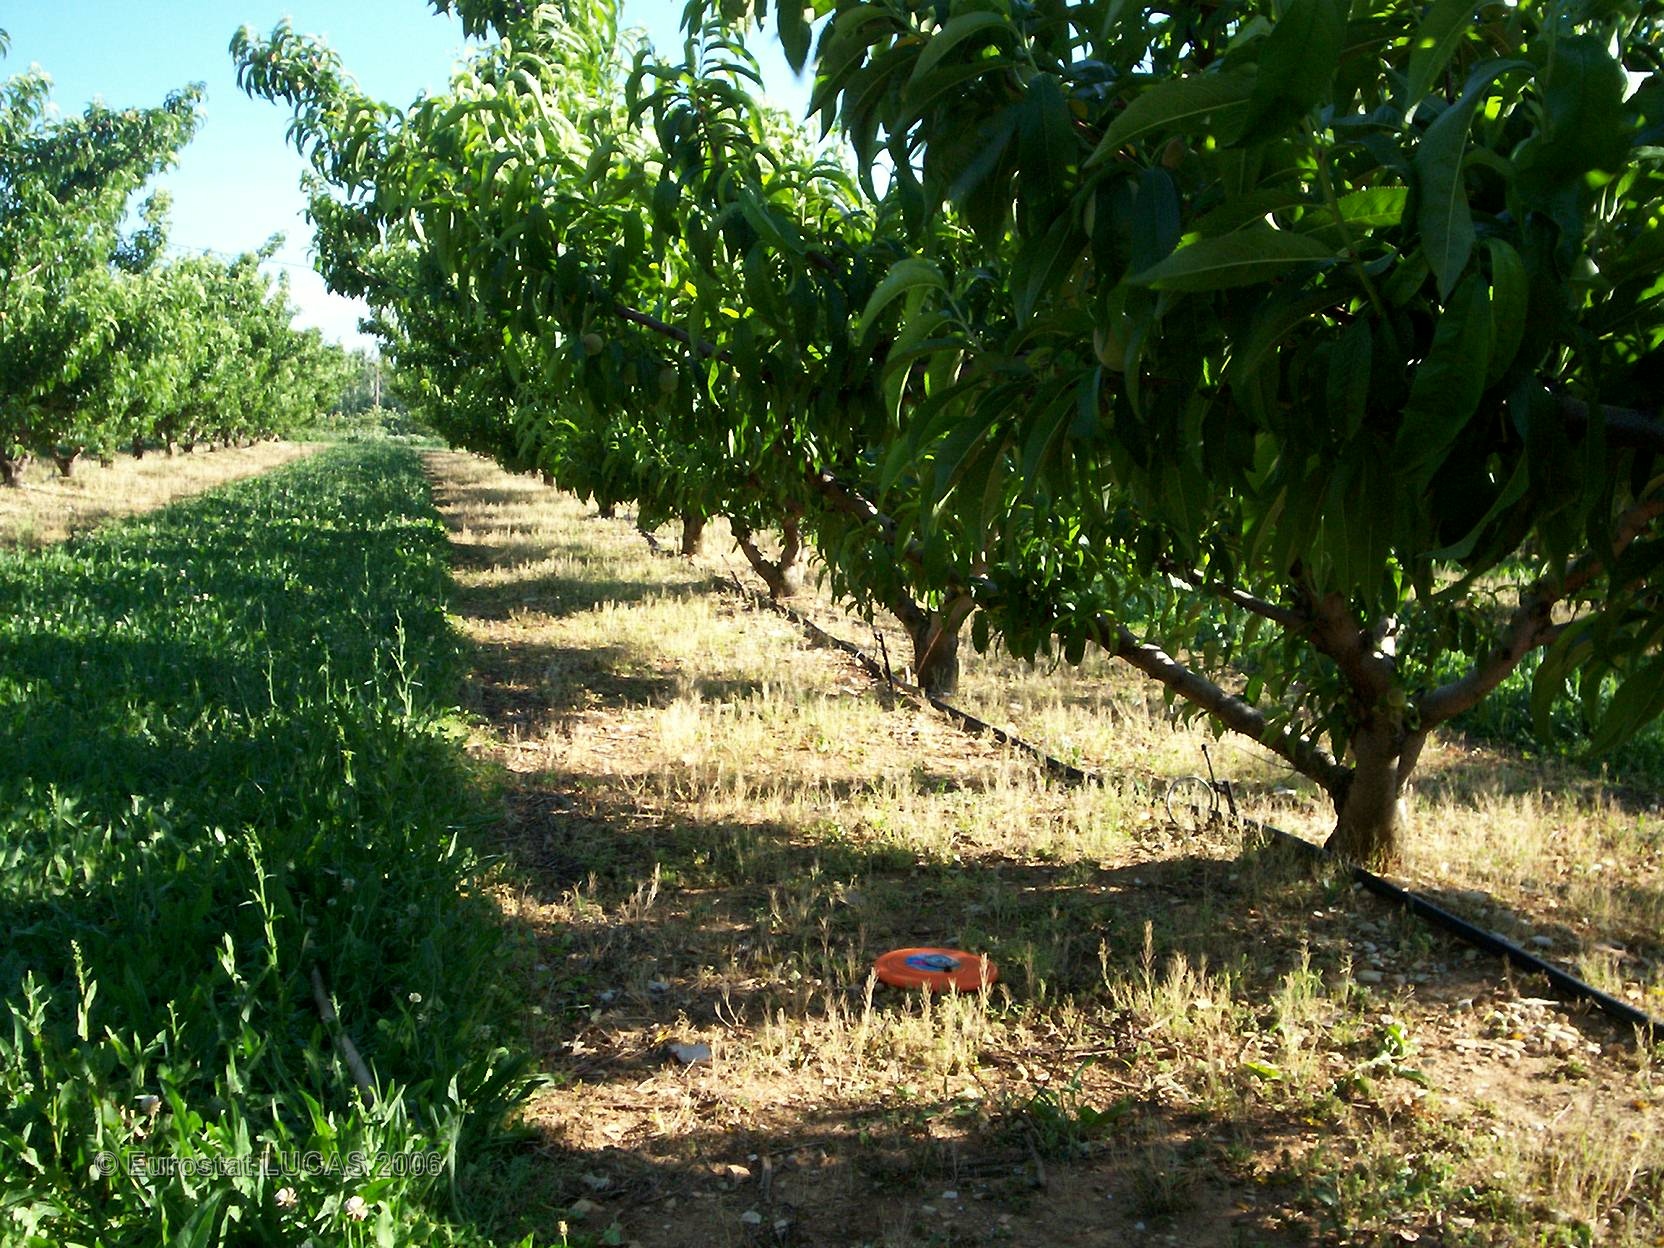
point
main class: Cropland
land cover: Other fruit trees and berries
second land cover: Grassland with sparse tree/shrub cover
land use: Agriculture (excluding fallow land and kitchen gardens)
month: May
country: FR
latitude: 44.6910
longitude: 4.8203
